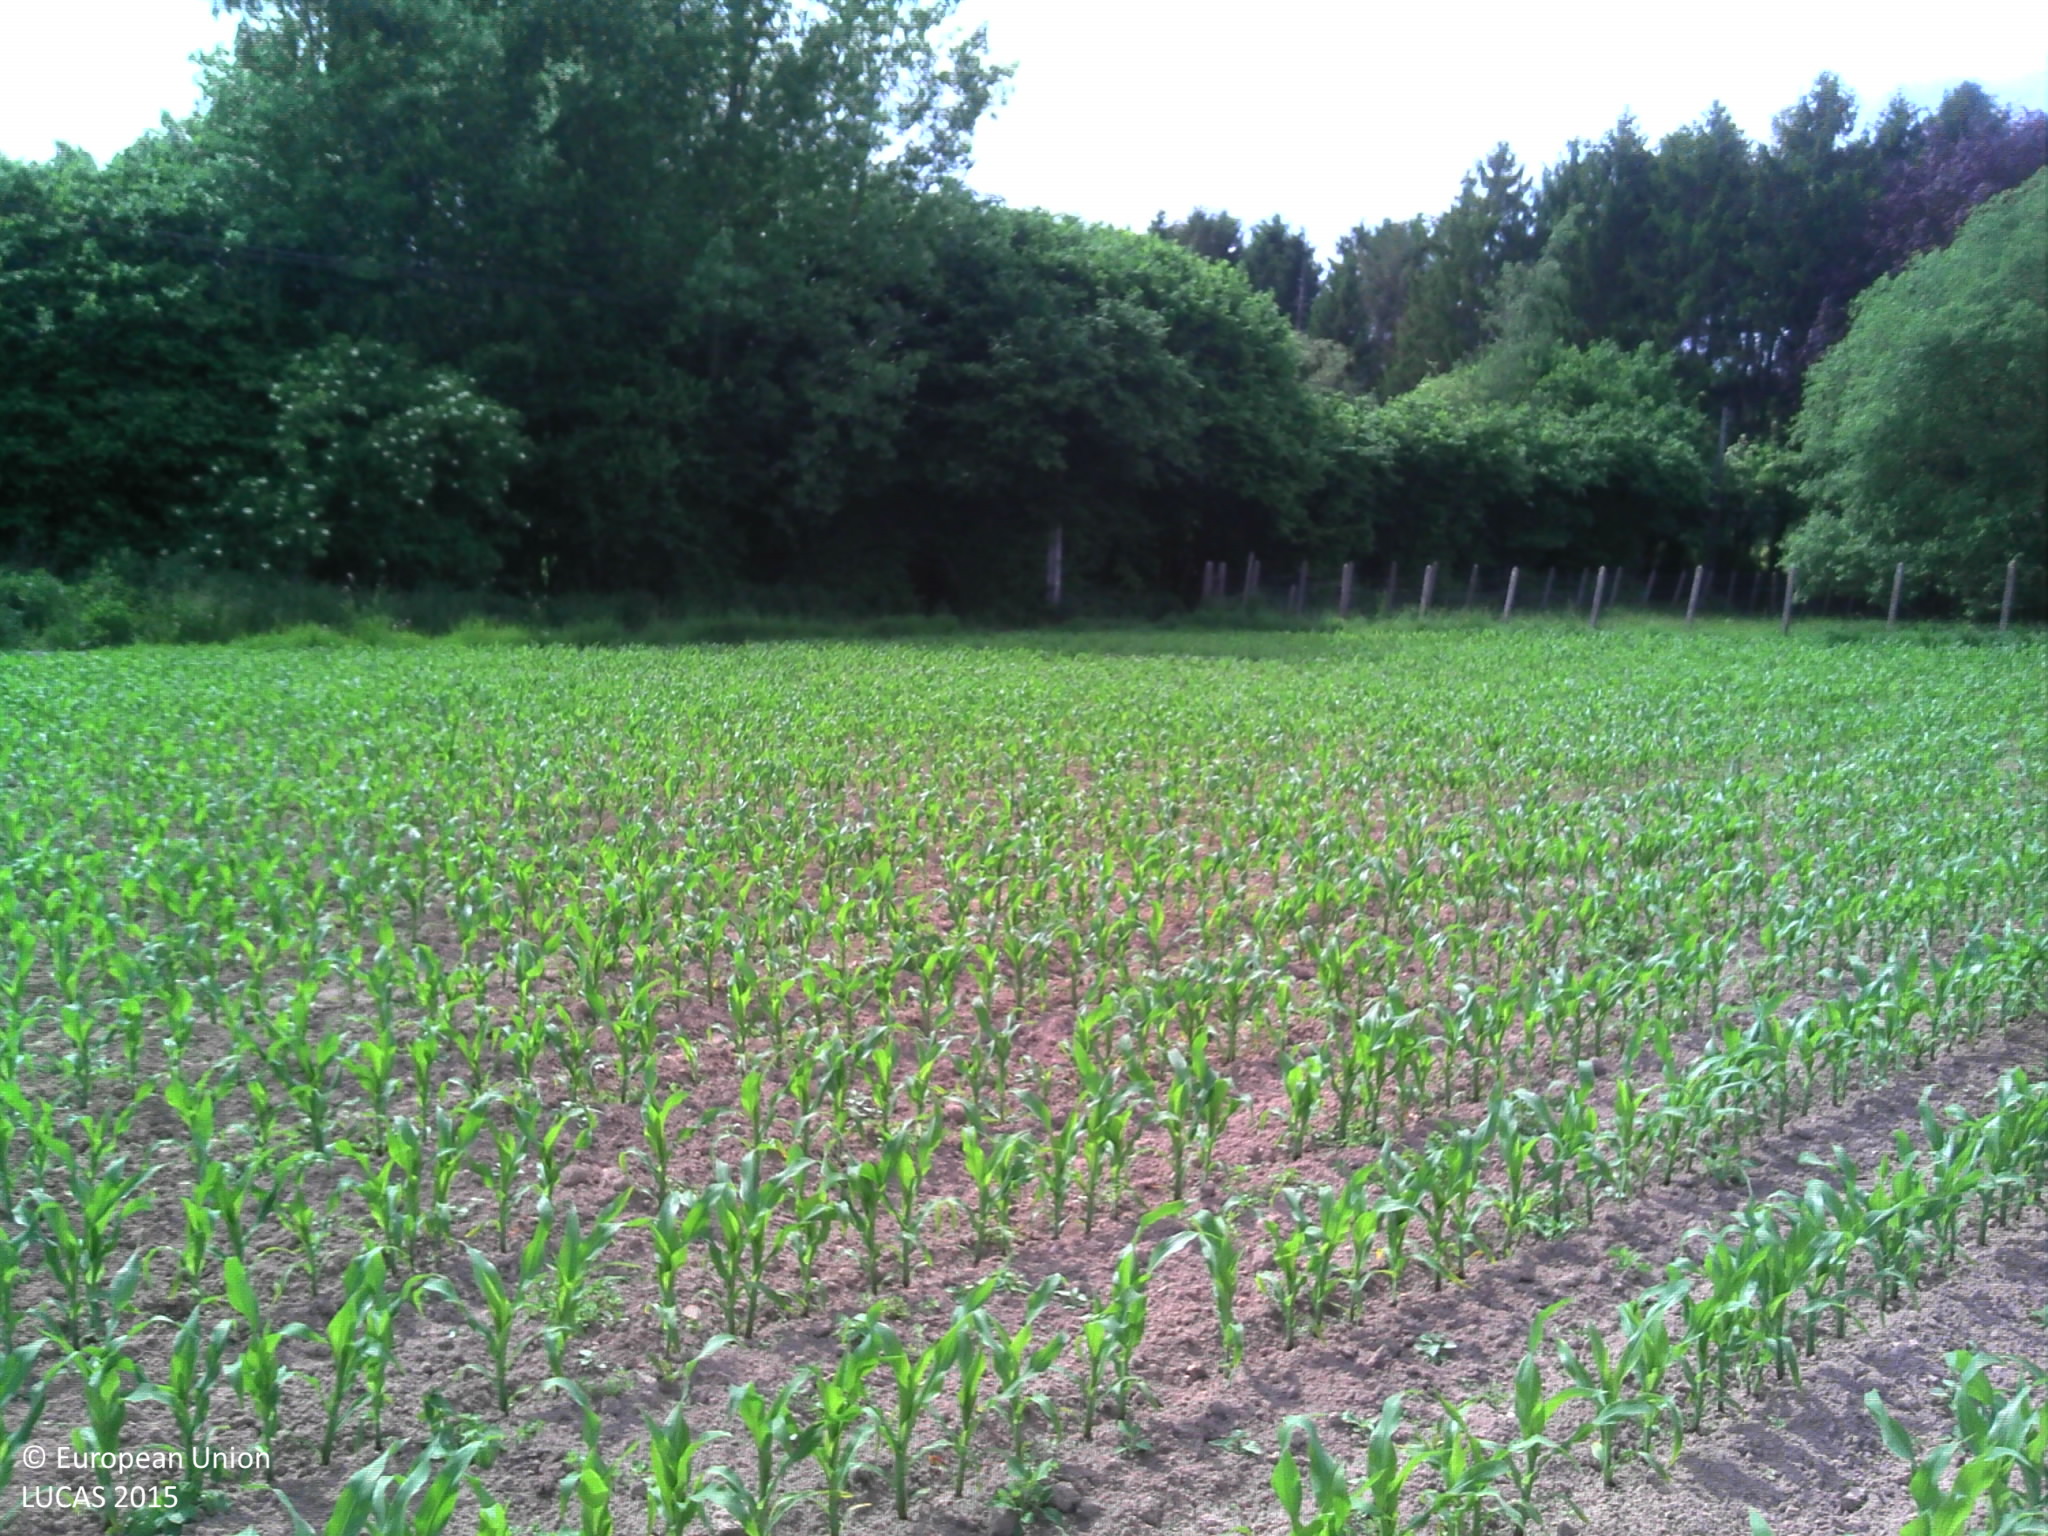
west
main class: Cropland
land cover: Maize
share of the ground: 25 - 50 %
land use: Agriculture (excluding fallow land and kitchen gardens)
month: May
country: BE
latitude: 50.7616
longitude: 4.6515
